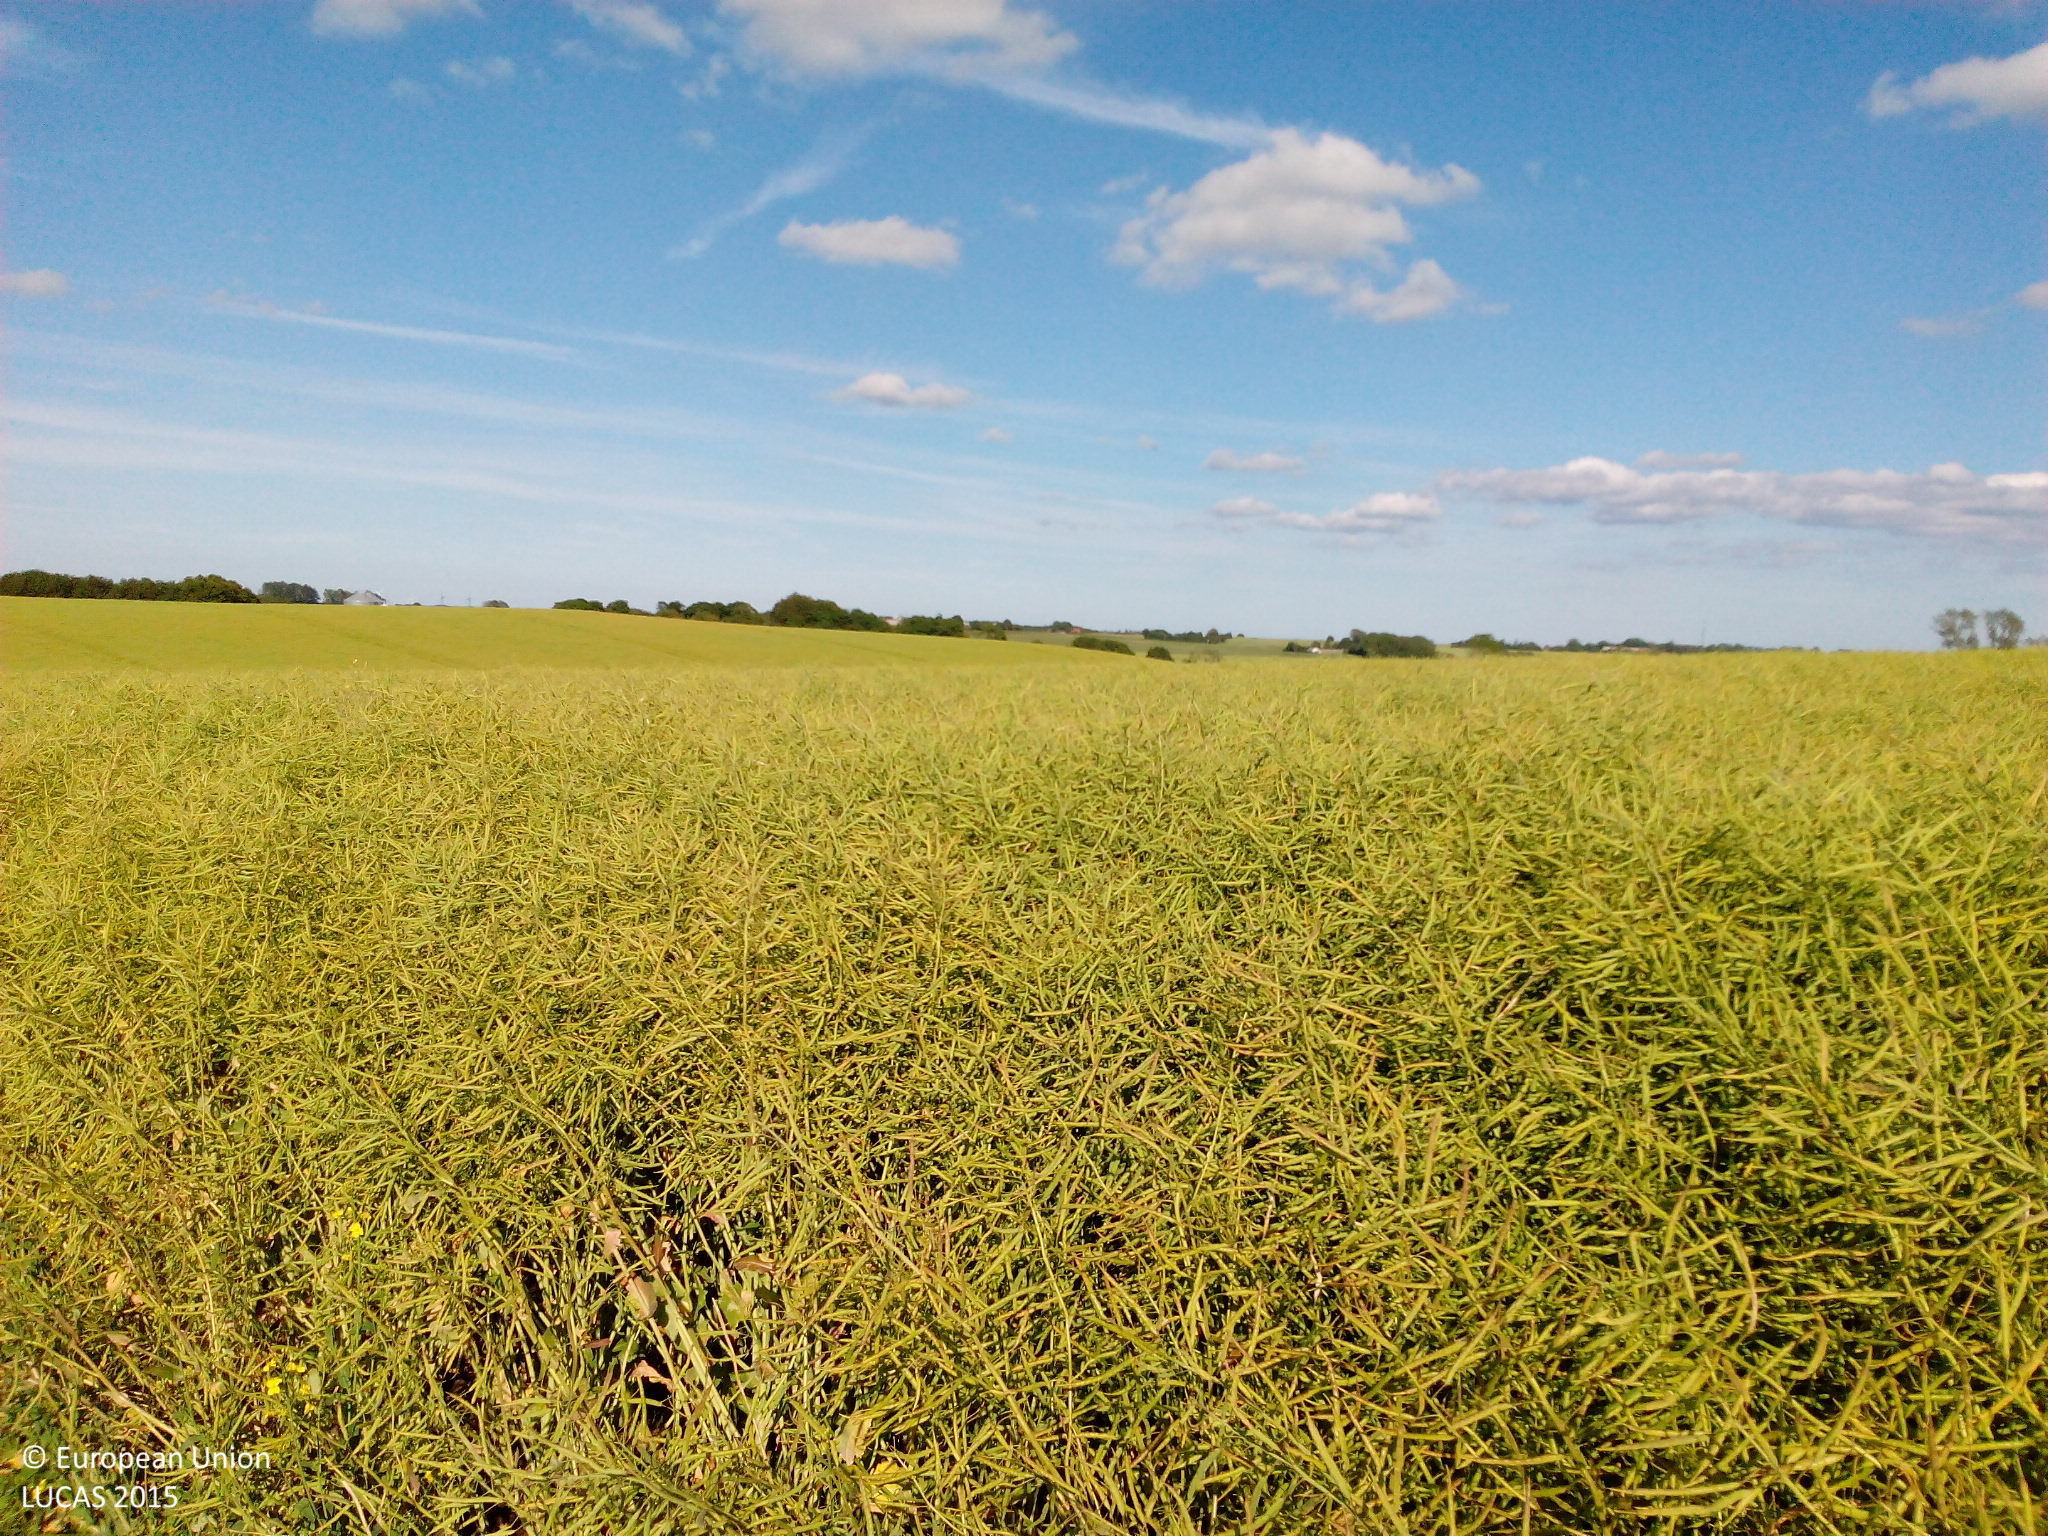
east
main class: Cropland
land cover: Rape and turnip rape
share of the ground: > 75 %
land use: Agriculture (excluding fallow land and kitchen gardens)
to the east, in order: Rape and turnip rape
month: June
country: DK
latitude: 56.3298
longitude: 10.6623
